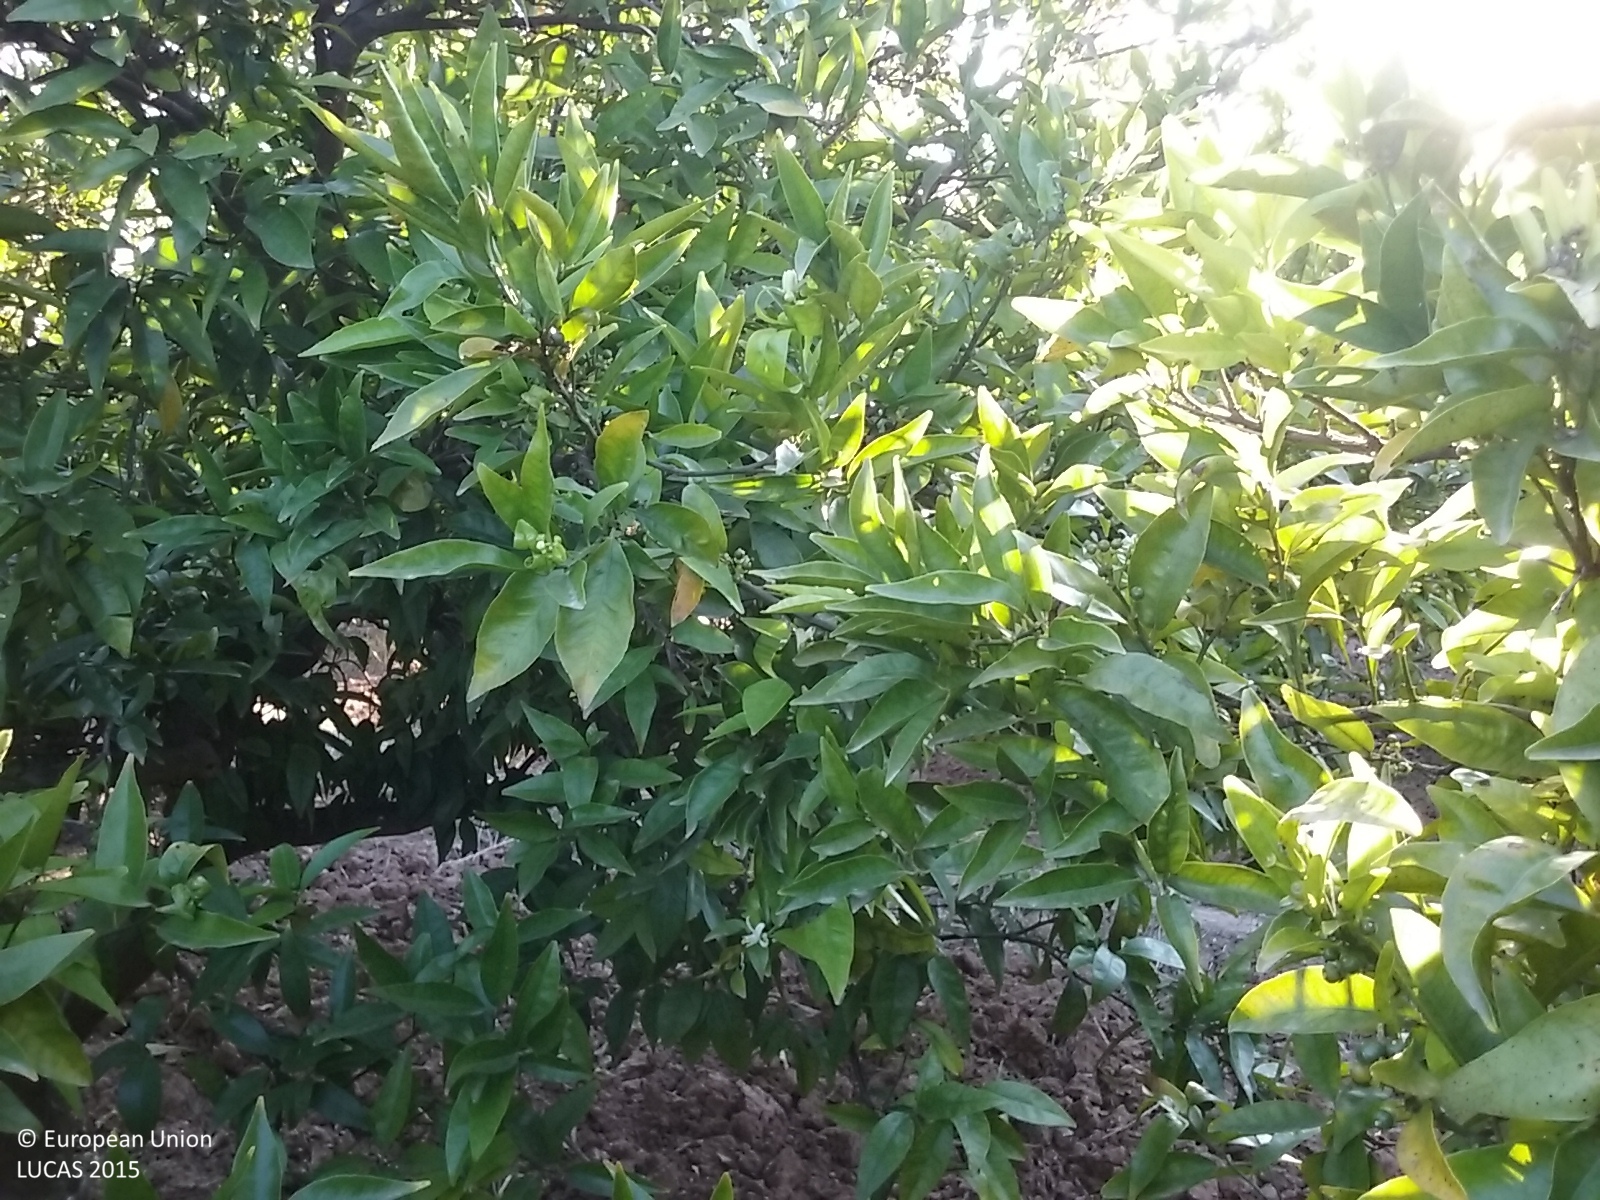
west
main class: Cropland
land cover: Other citrus fruit
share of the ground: 50 - 75 %
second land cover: Other bare soil
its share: > 75 %
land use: Agriculture (excluding fallow land and kitchen gardens)
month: May
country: ES
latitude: 39.9343
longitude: -0.0291
